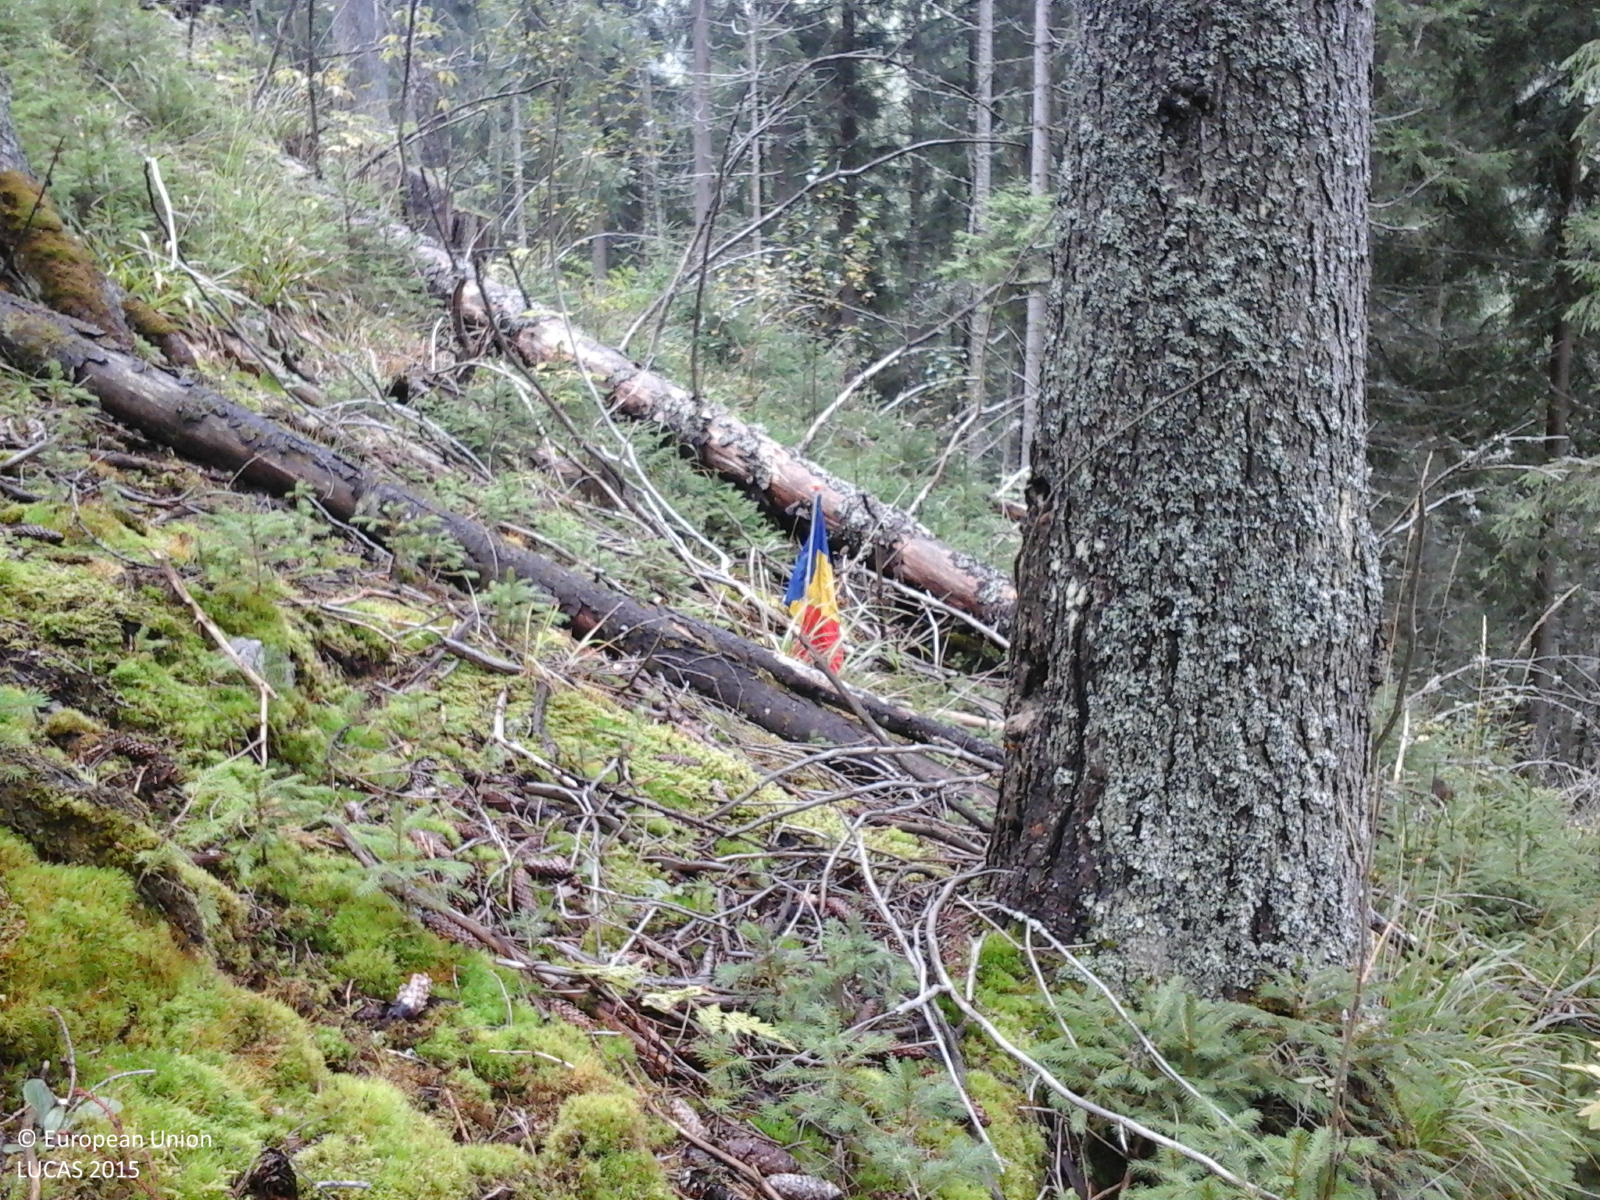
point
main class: Woodland
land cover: Spruce dominated coniferous woodland
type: alpine coniferous forest
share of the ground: > 75 %
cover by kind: coniferous forest trees 90 %, shrubs 5 %, herbaceous plants 5 %
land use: Forestry
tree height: > 5 m
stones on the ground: 25 - 50 %
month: October
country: RO
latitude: 46.5684
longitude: 23.2009
